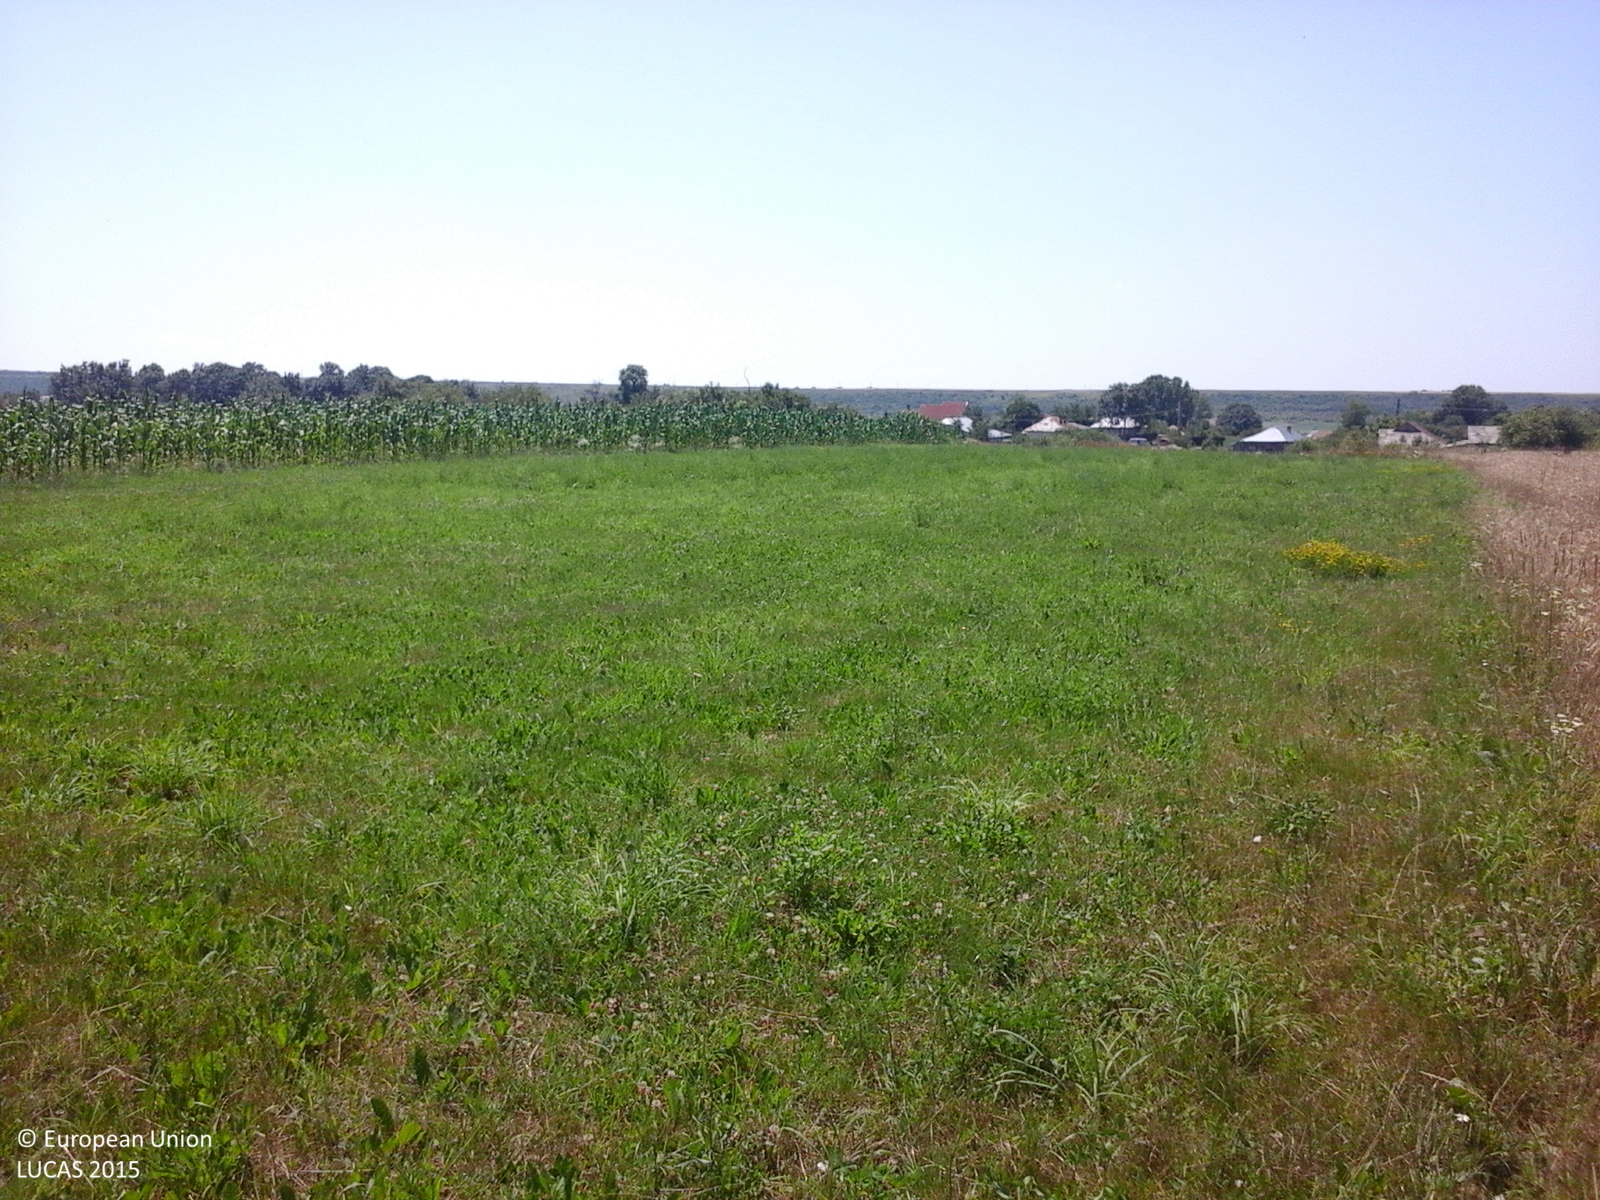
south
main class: Cropland
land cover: Common wheat
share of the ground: > 75 %
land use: Agriculture (excluding fallow land and kitchen gardens)
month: July
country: RO
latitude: 44.4765
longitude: 24.6445
